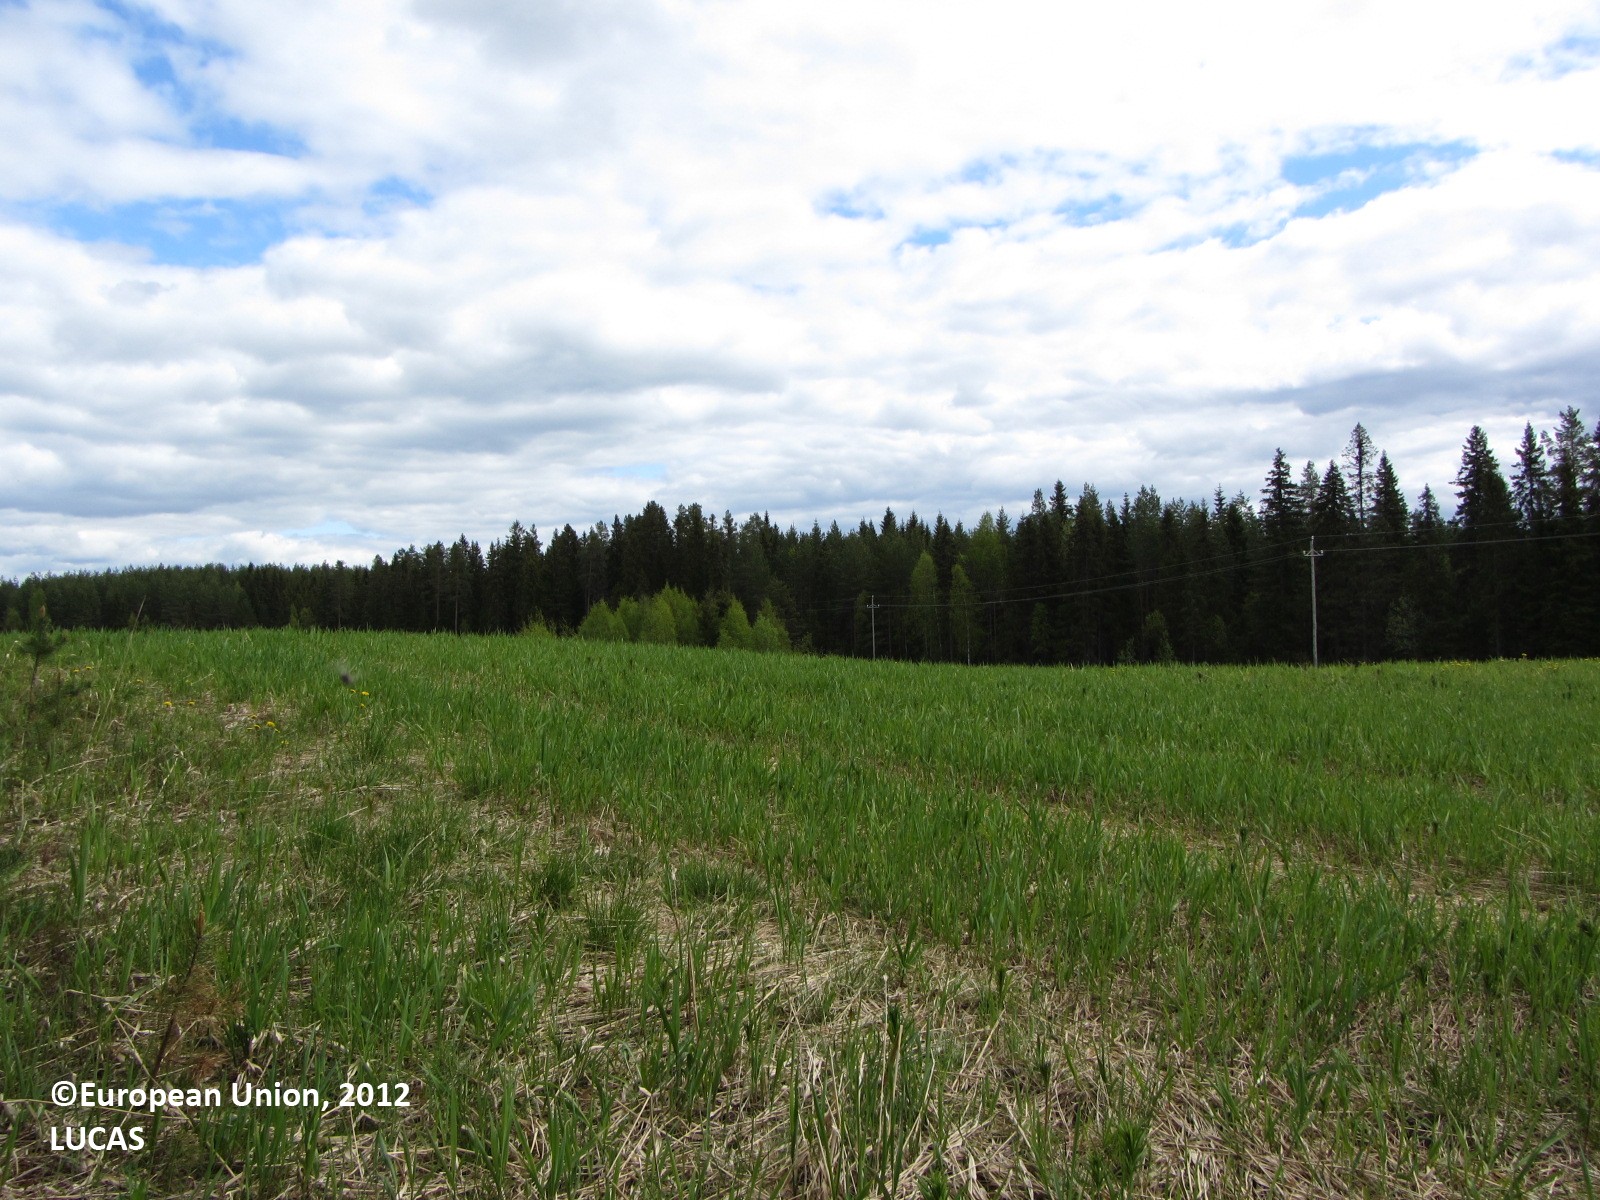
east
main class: Cropland
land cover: Temporary grasslands
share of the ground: > 75 %
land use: Agriculture (excluding fallow land and kitchen gardens)
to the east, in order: Temporary grasslands; Grassland with sparse tree/shrub cover; Temporary grasslands
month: May
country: FI
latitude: 62.4890
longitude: 25.4606
